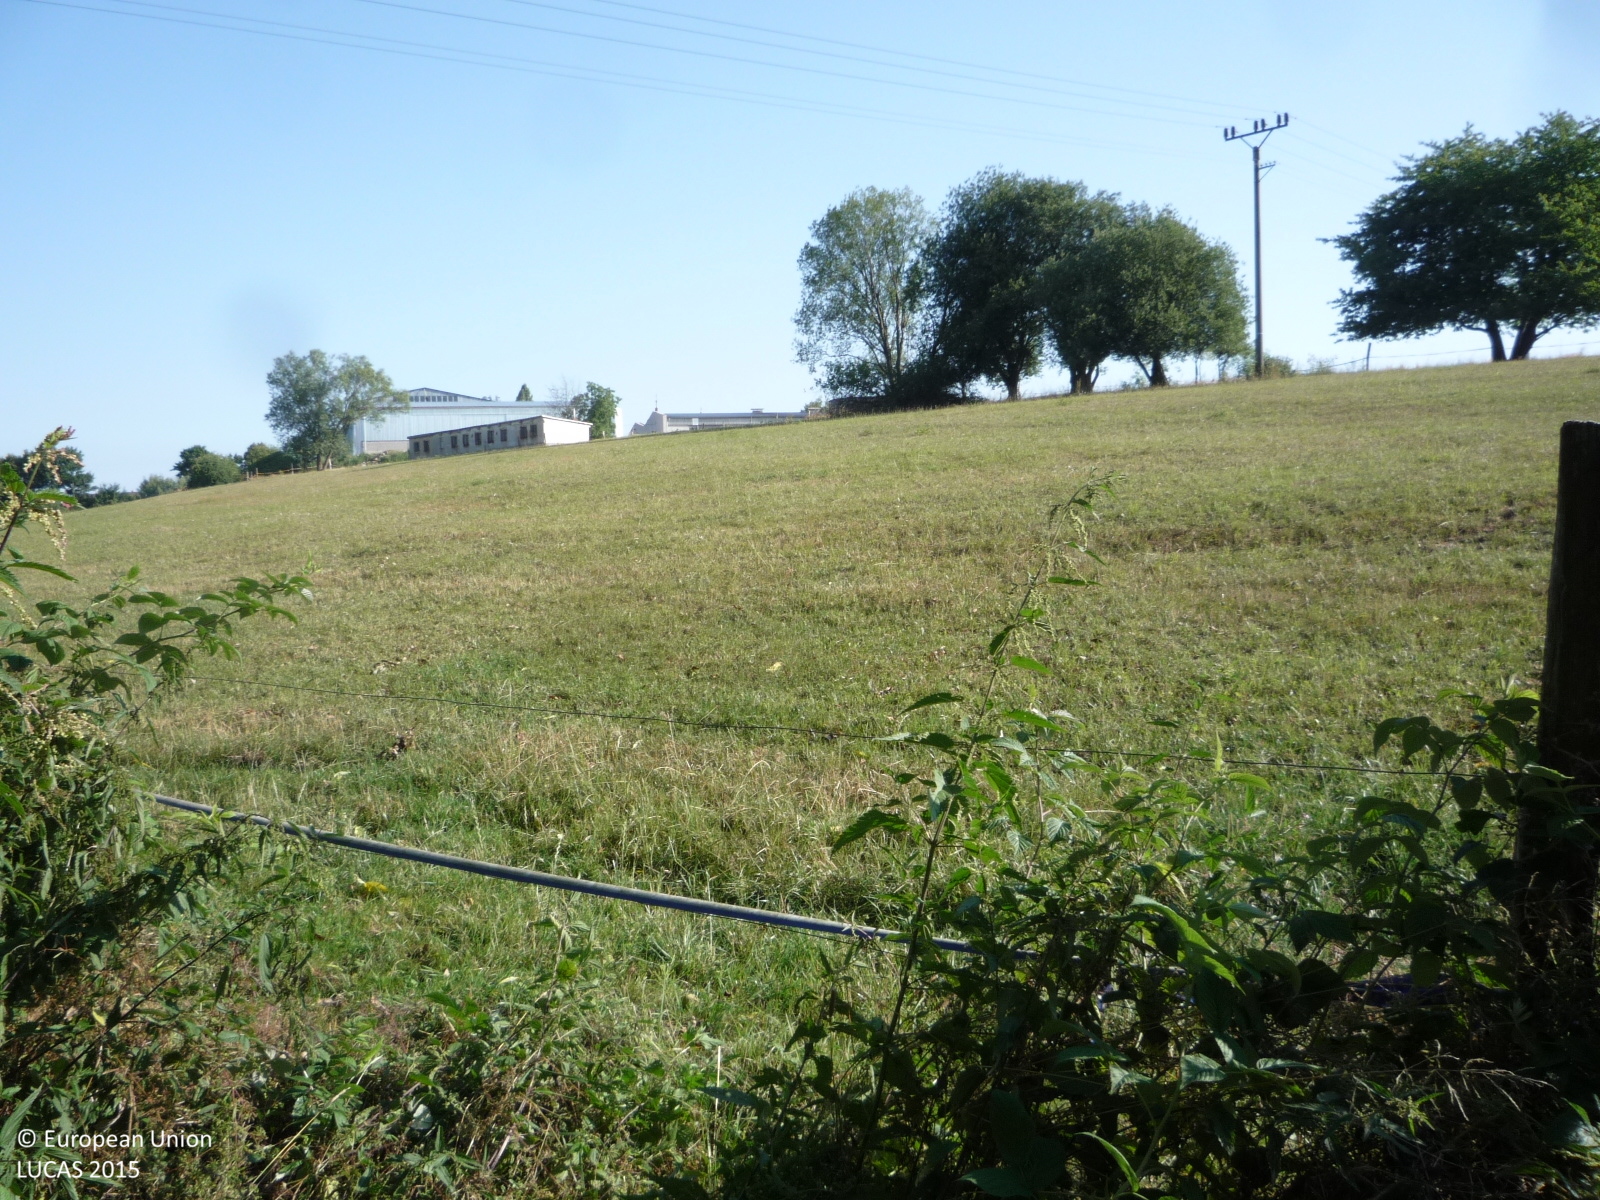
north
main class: Grassland
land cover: Grassland without tree/shrub cover
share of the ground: > 75 %
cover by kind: herbaceous plants 100 %
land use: Agriculture (excluding fallow land and kitchen gardens)
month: July
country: CZ
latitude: 50.4261
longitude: 15.1975
